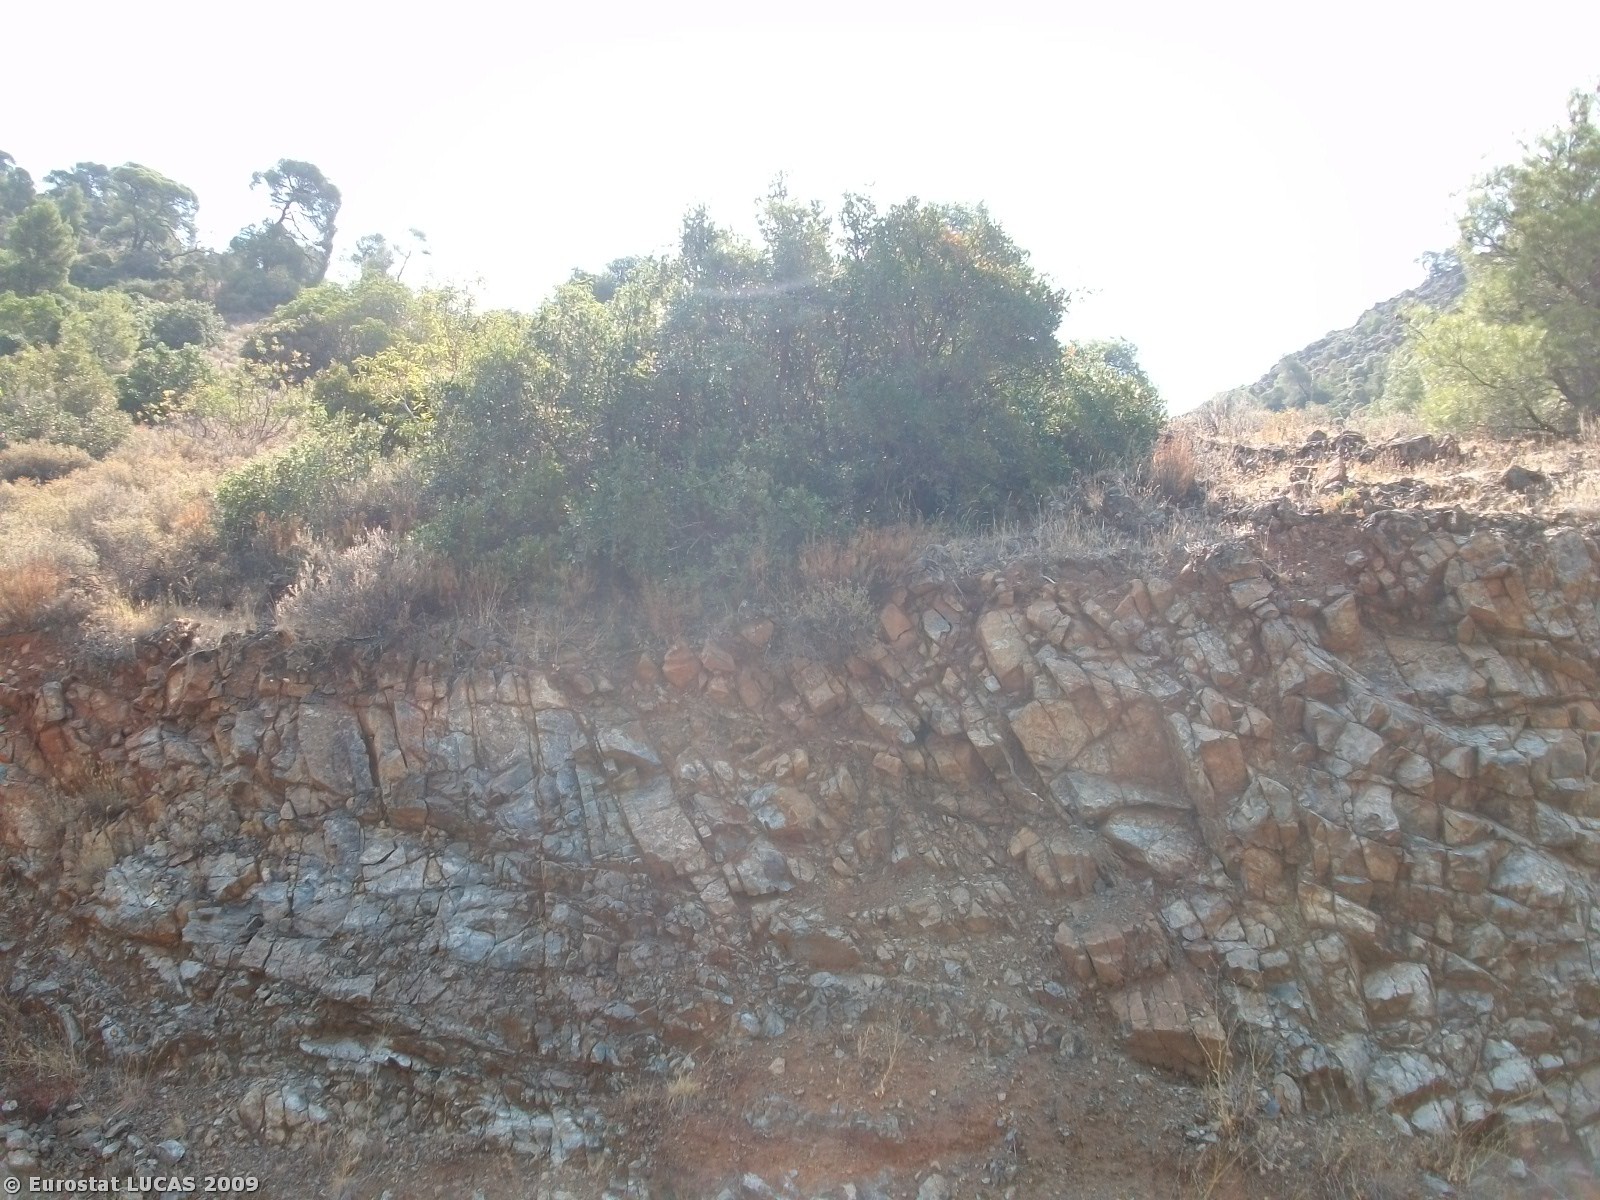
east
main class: Shrubland
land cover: Shrubland with sparse tree cover
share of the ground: 50 - 75 %
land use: Unused
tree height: < 5 m
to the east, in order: Shrubland with sparse tree cover; Coniferous woodland
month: August
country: GR
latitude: 38.5933
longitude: 23.1290
